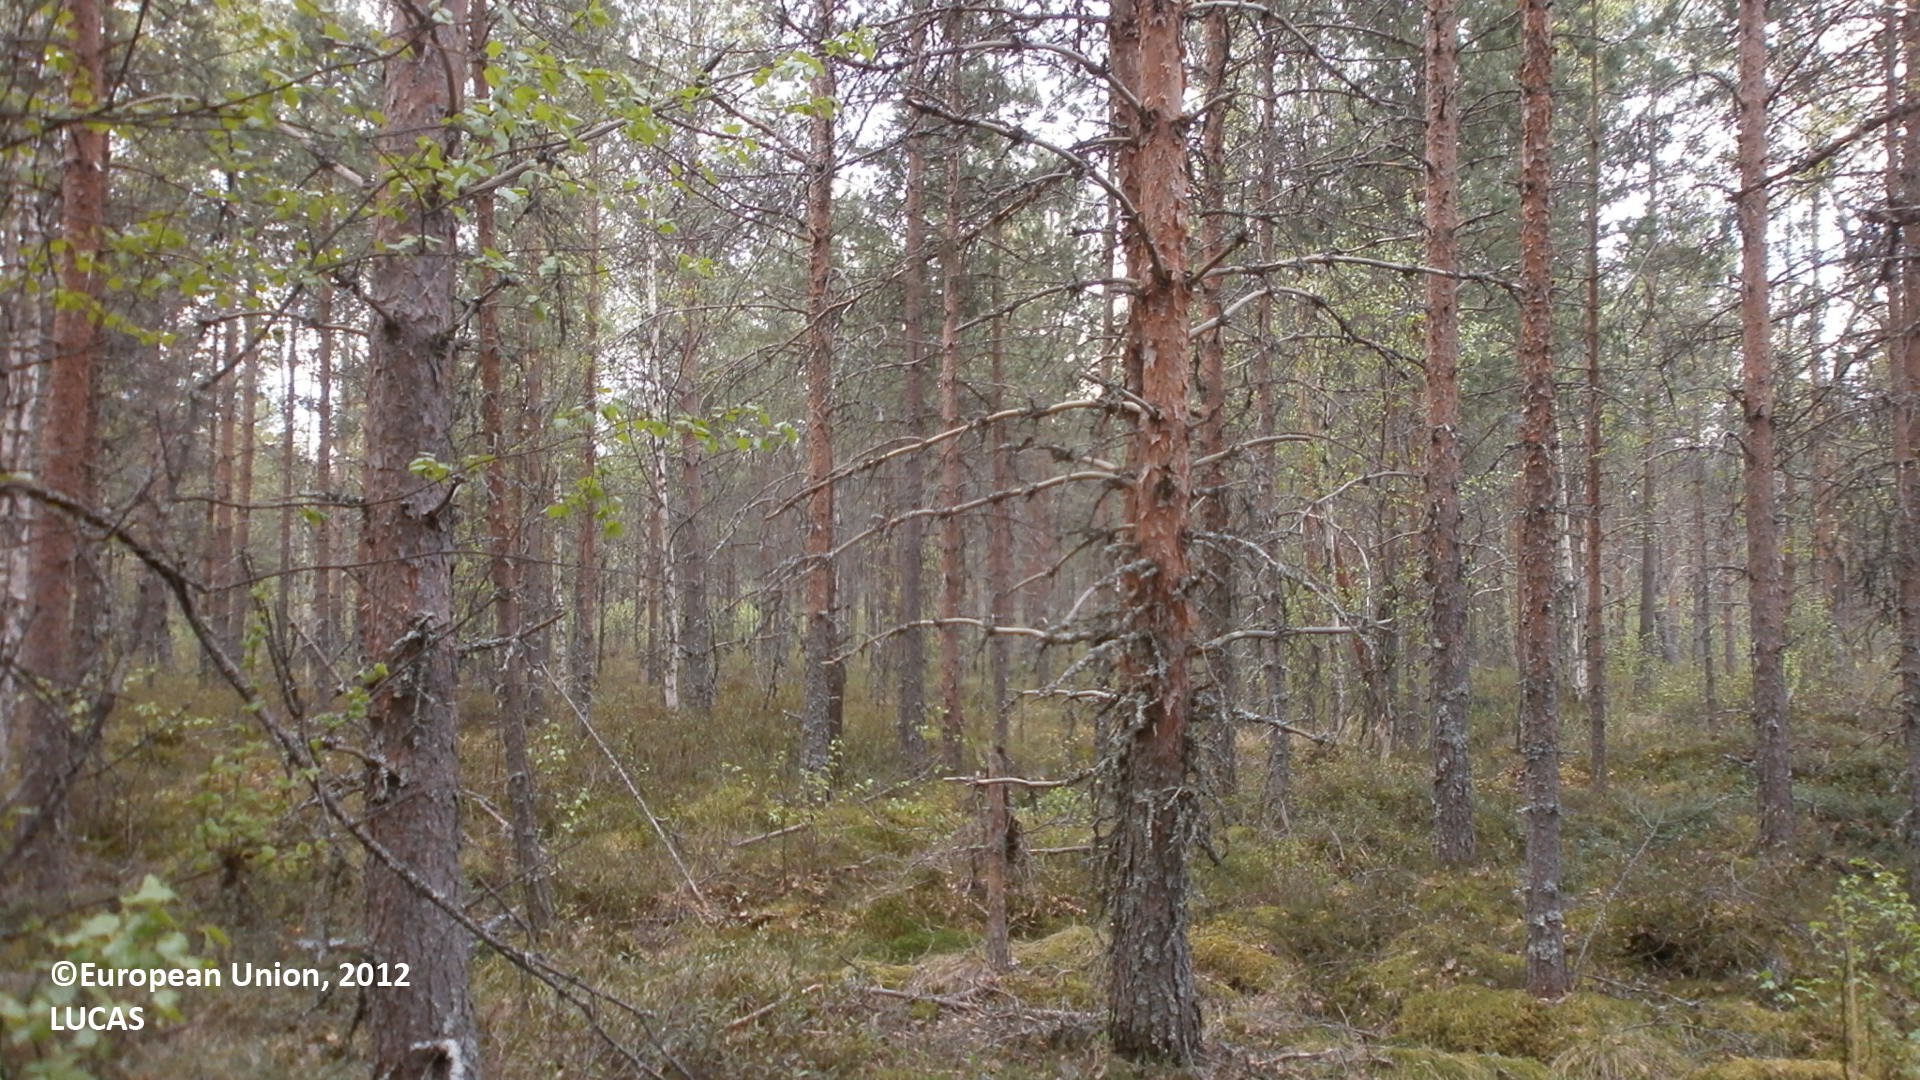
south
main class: Woodland
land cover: Pine dominated coniferous woodland
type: mire and swamp forests
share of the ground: > 75 %
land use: Forestry
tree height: > 5 m
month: May
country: FI
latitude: 64.4744
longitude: 25.9284
